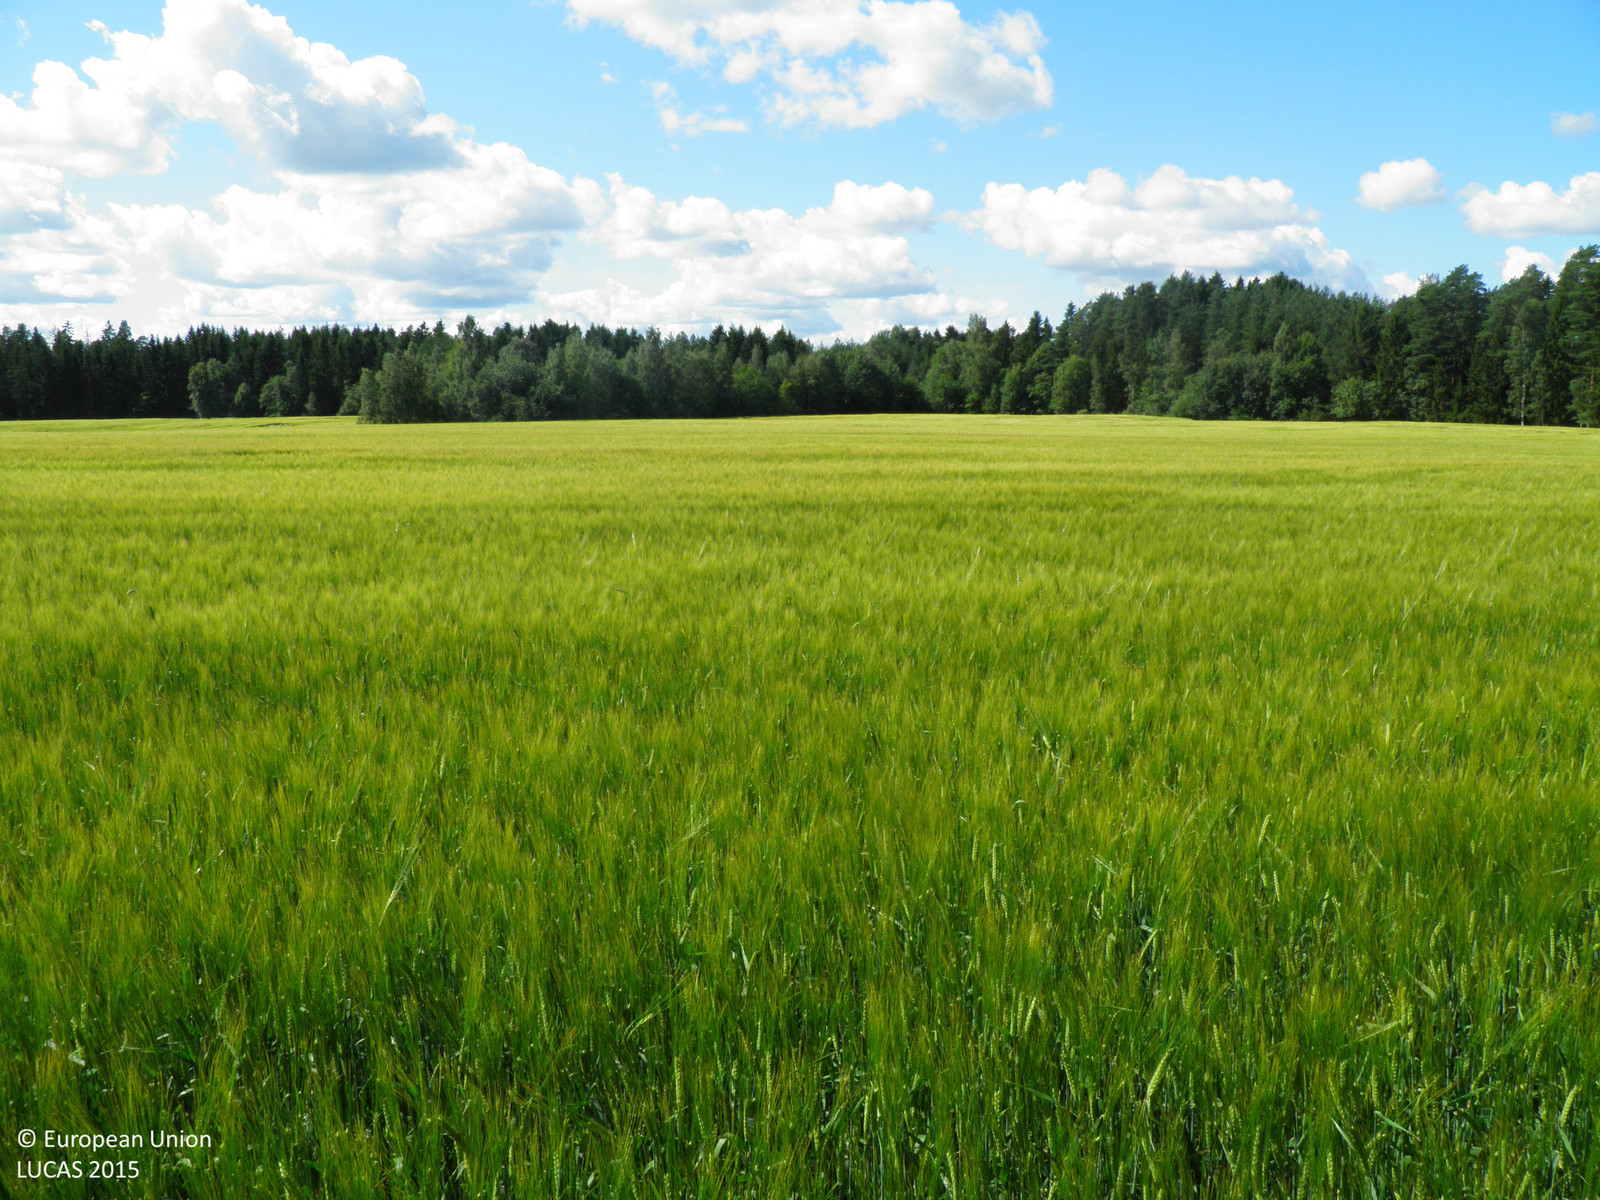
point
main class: Cropland
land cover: Barley
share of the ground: > 75 %
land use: Agriculture (excluding fallow land and kitchen gardens)
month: August
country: FI
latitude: 60.9381
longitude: 22.8997
